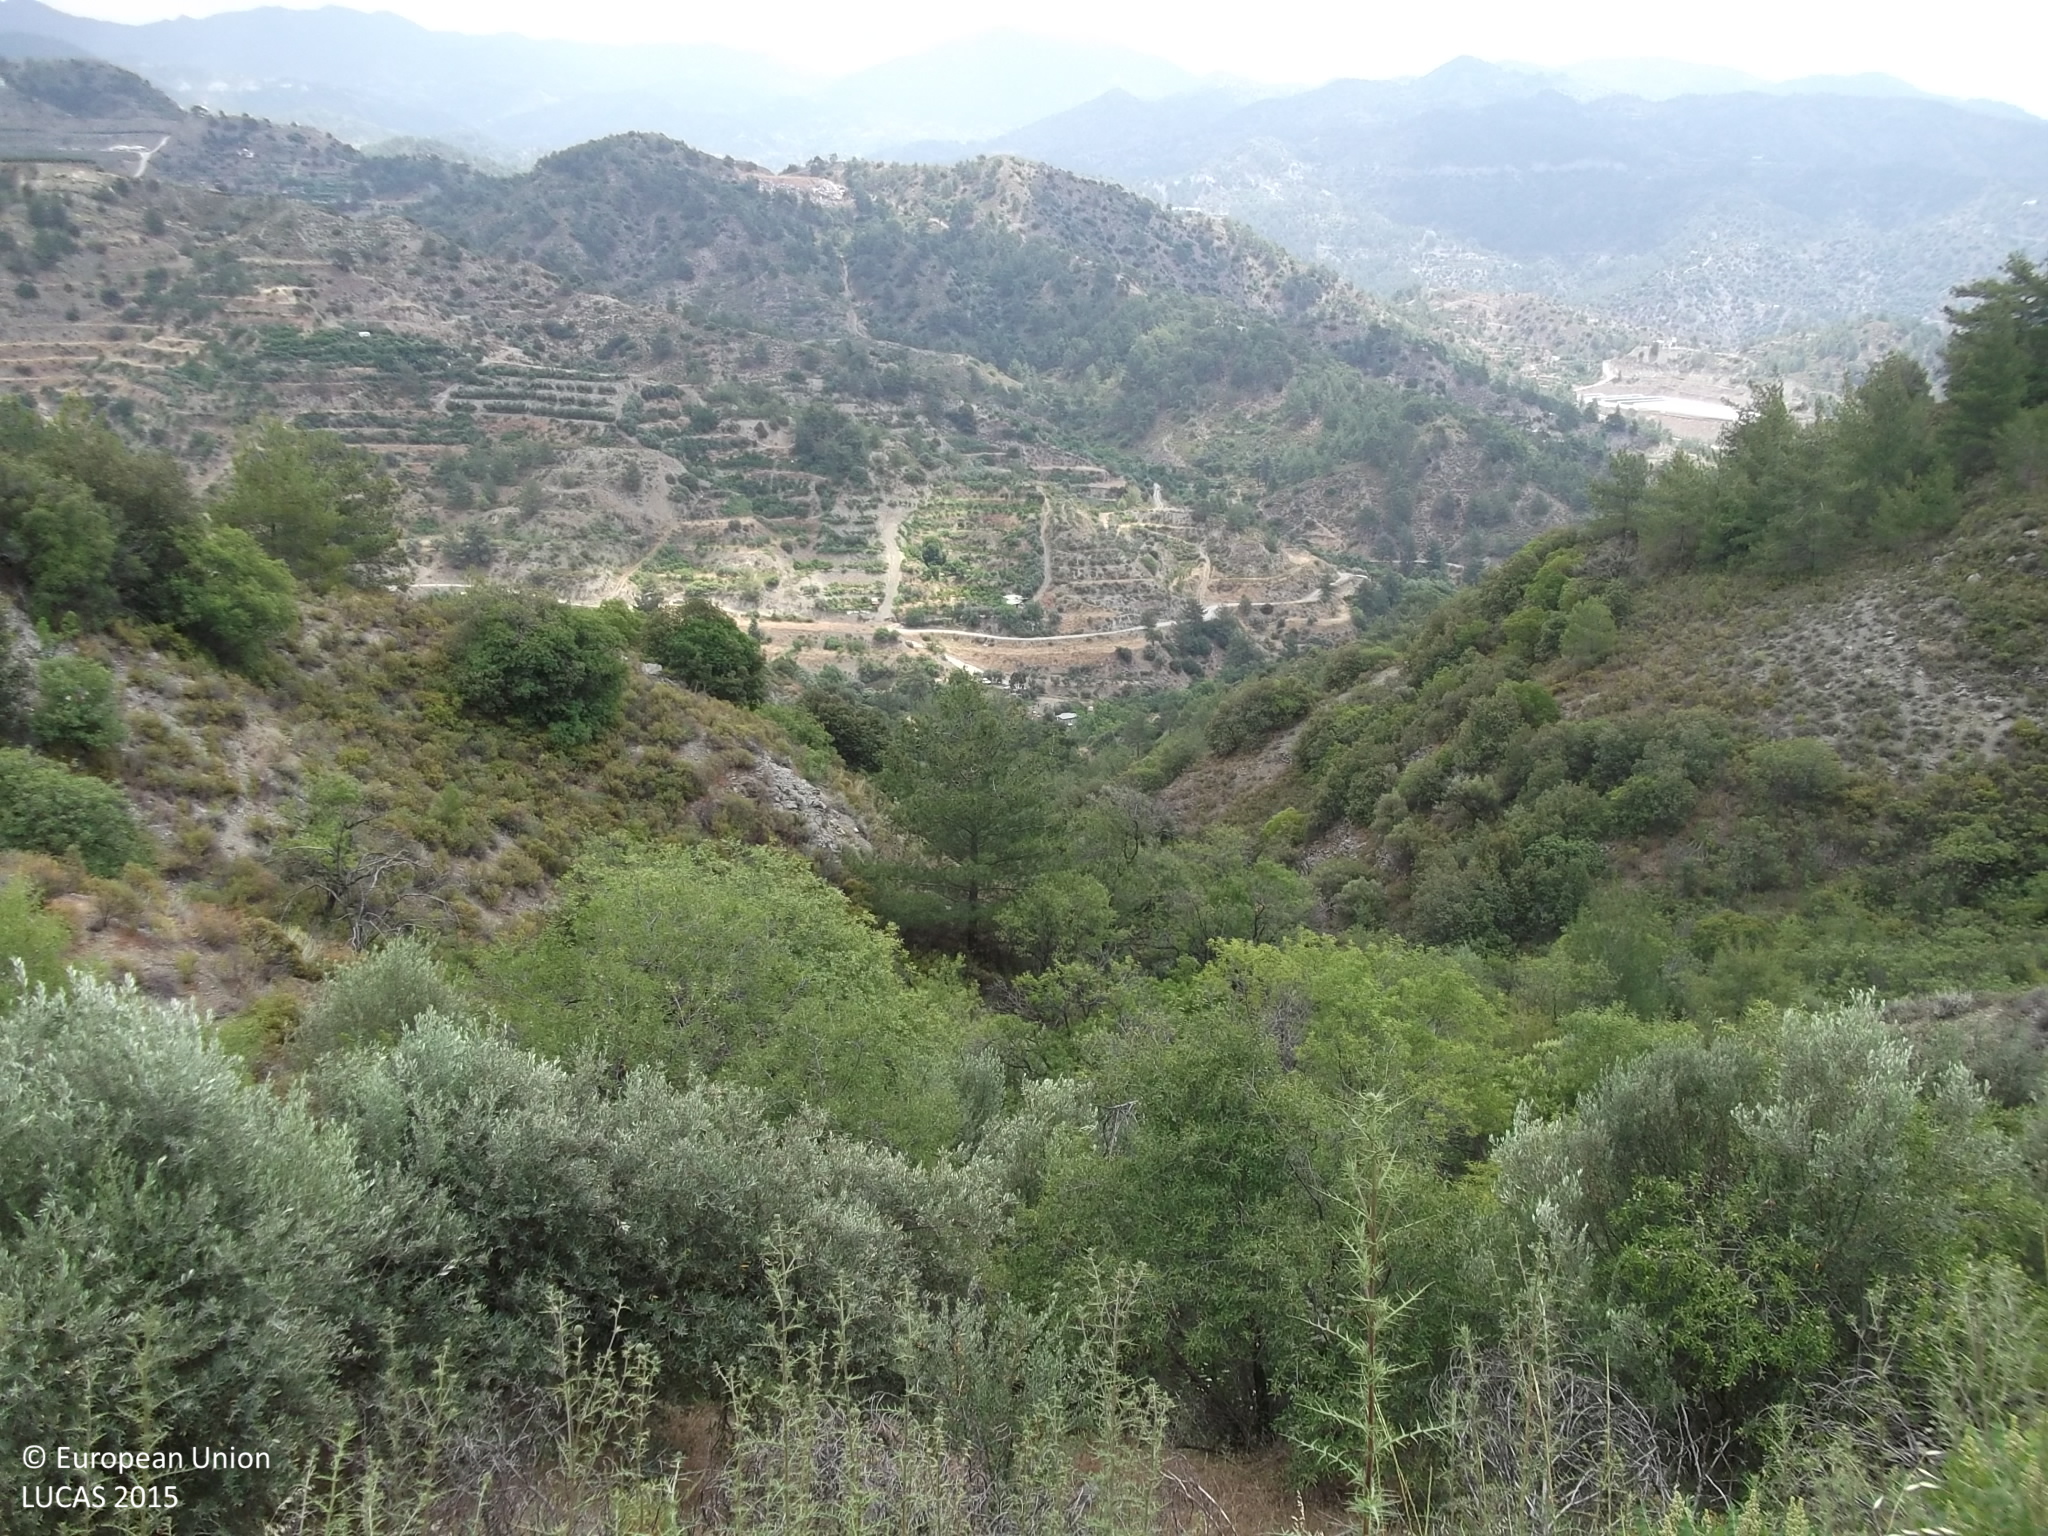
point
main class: Woodland
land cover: Pine dominated mixed woodland
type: coniferous forest of the mediterranean region
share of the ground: 25 - 50 %
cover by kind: coniferous forest trees 45 %, shrubs 25 %, broadleaved forest trees 15 %, consolidated bare surface 15 %
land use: Forestry
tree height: > 5 m
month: June
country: CY
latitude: 34.8798
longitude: 32.9578
